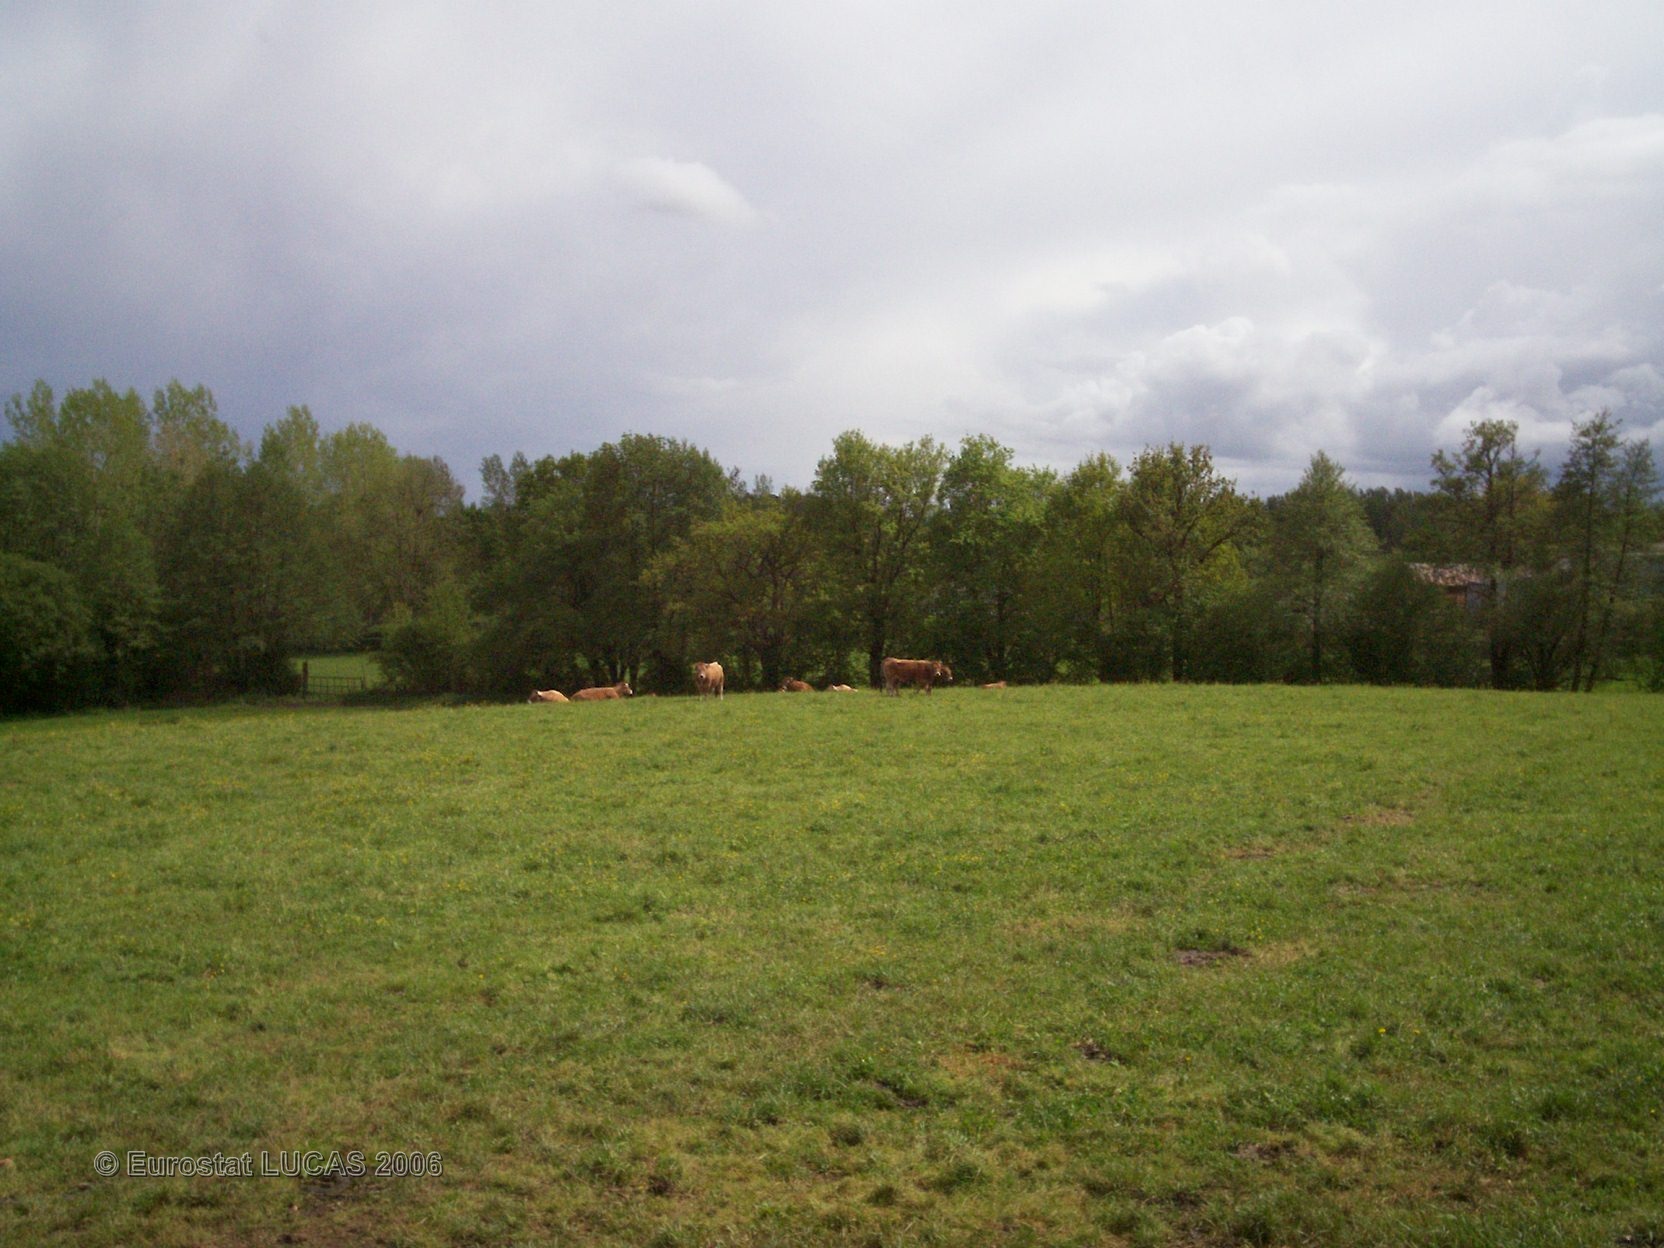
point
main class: Grassland
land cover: Grassland without tree/shrub cover
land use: Agriculture (excluding fallow land and kitchen gardens)
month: May
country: FR
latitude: 46.5995
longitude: -0.2722
